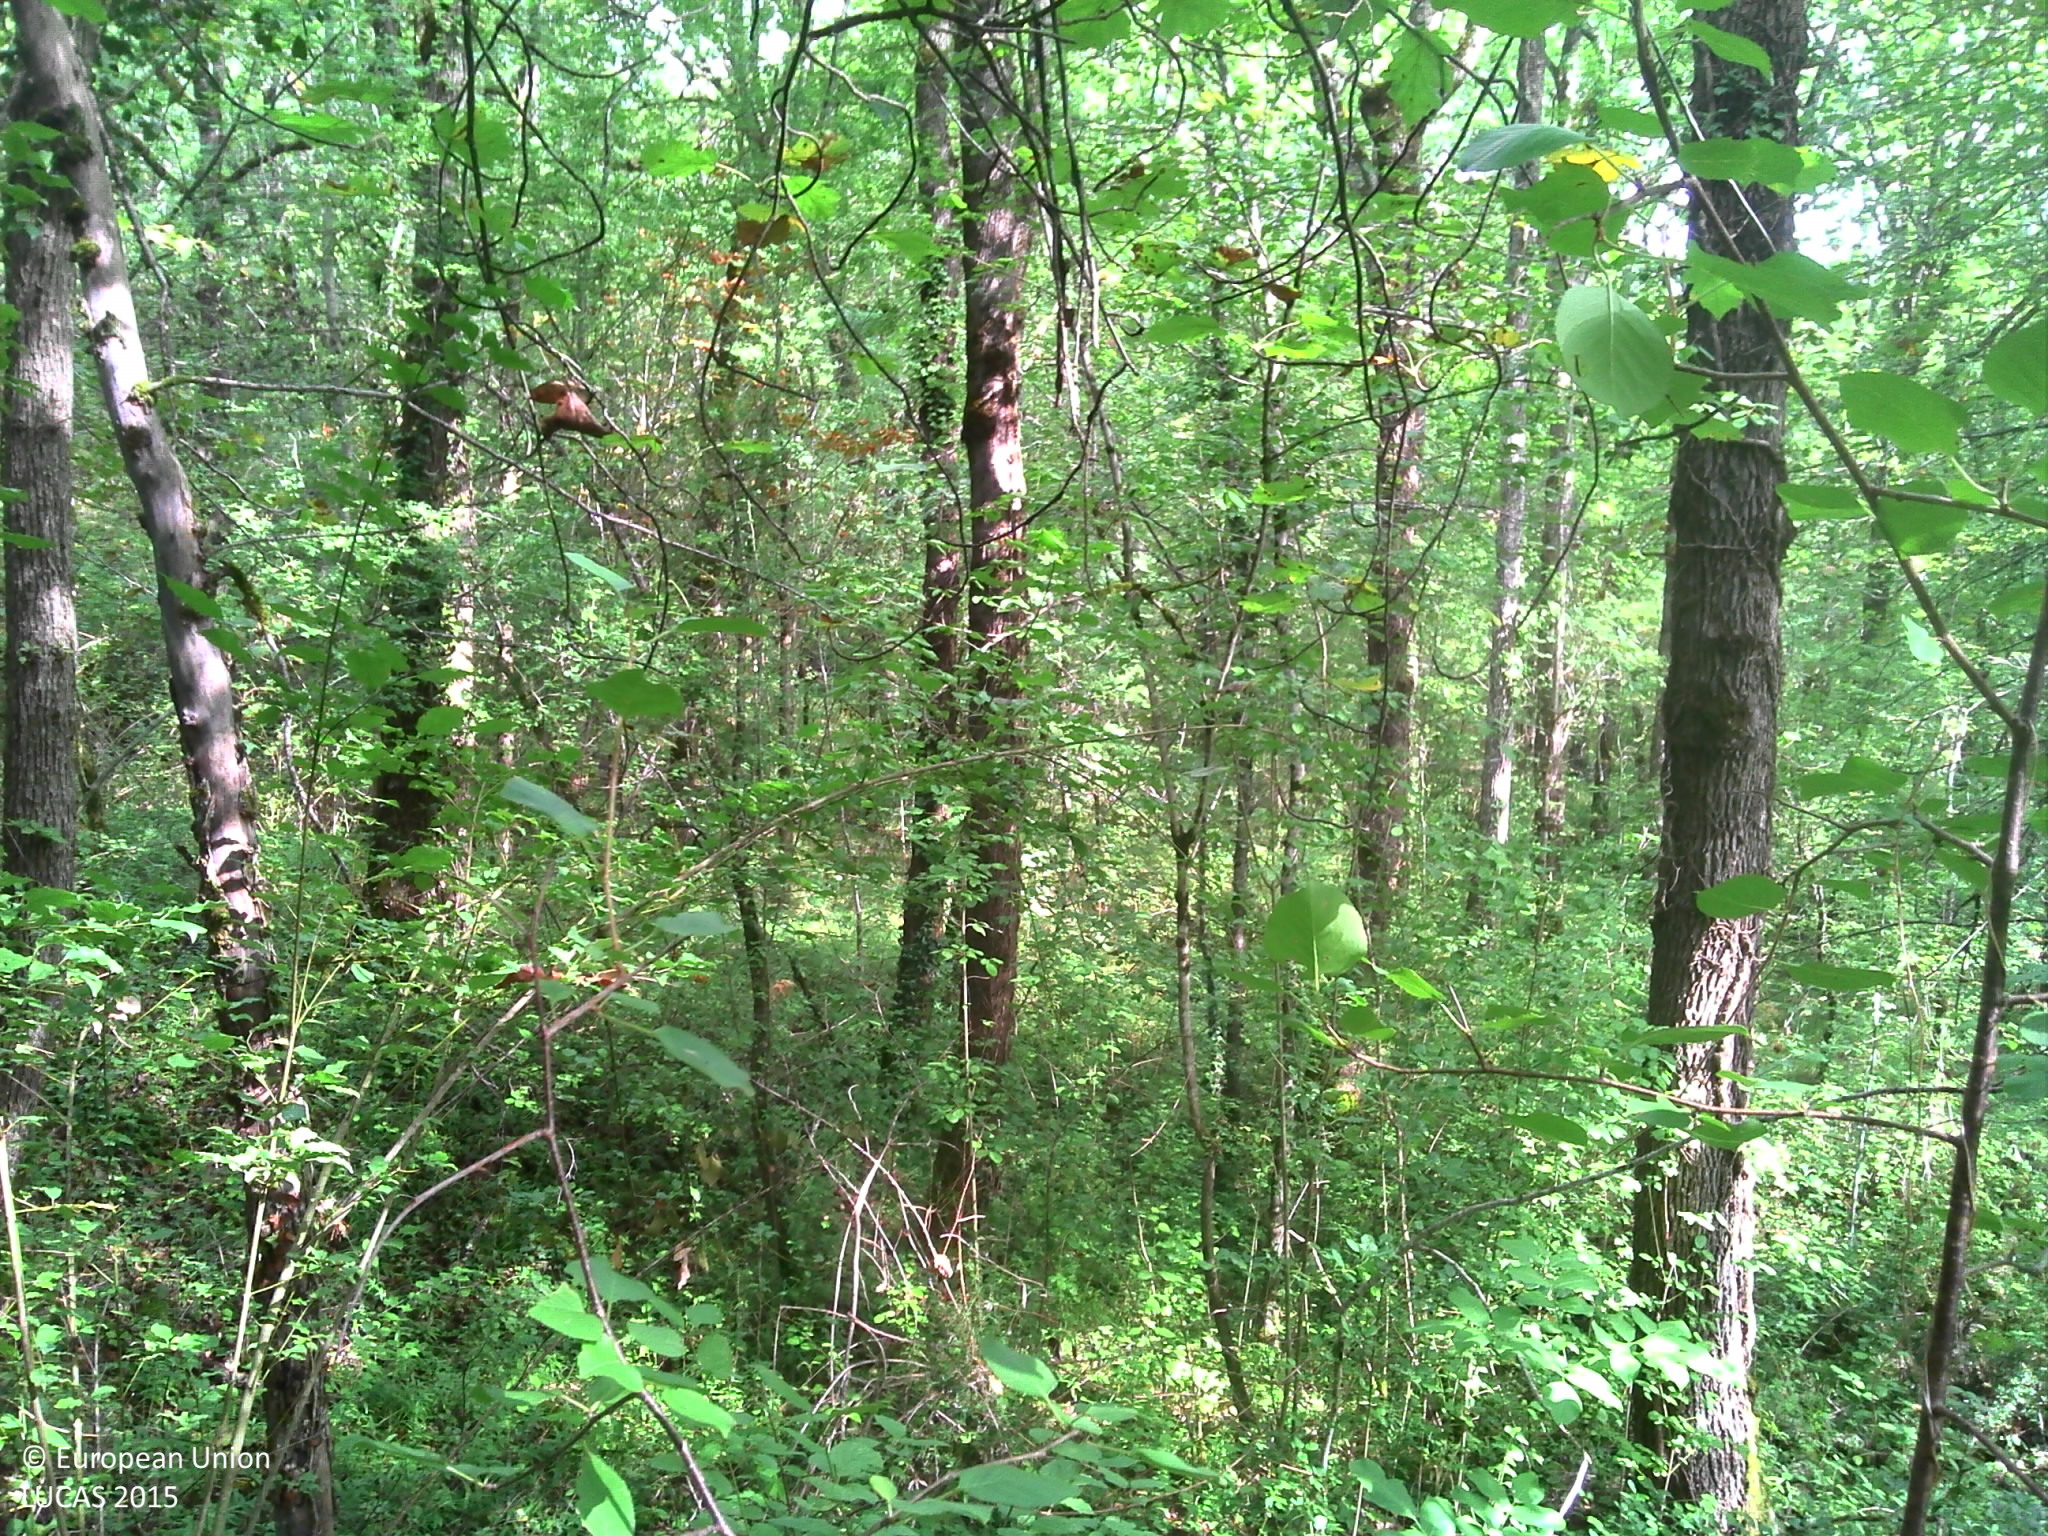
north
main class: Woodland
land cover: Broadleaved woodland
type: mesophytic deciduous forest
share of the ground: > 75 %
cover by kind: broadleaved forest trees 80 %, shrubs 10 %, herbaceous plants 10 %
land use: Forestry
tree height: > 5 m
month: August
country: FR
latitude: 44.2581
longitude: 1.3184
